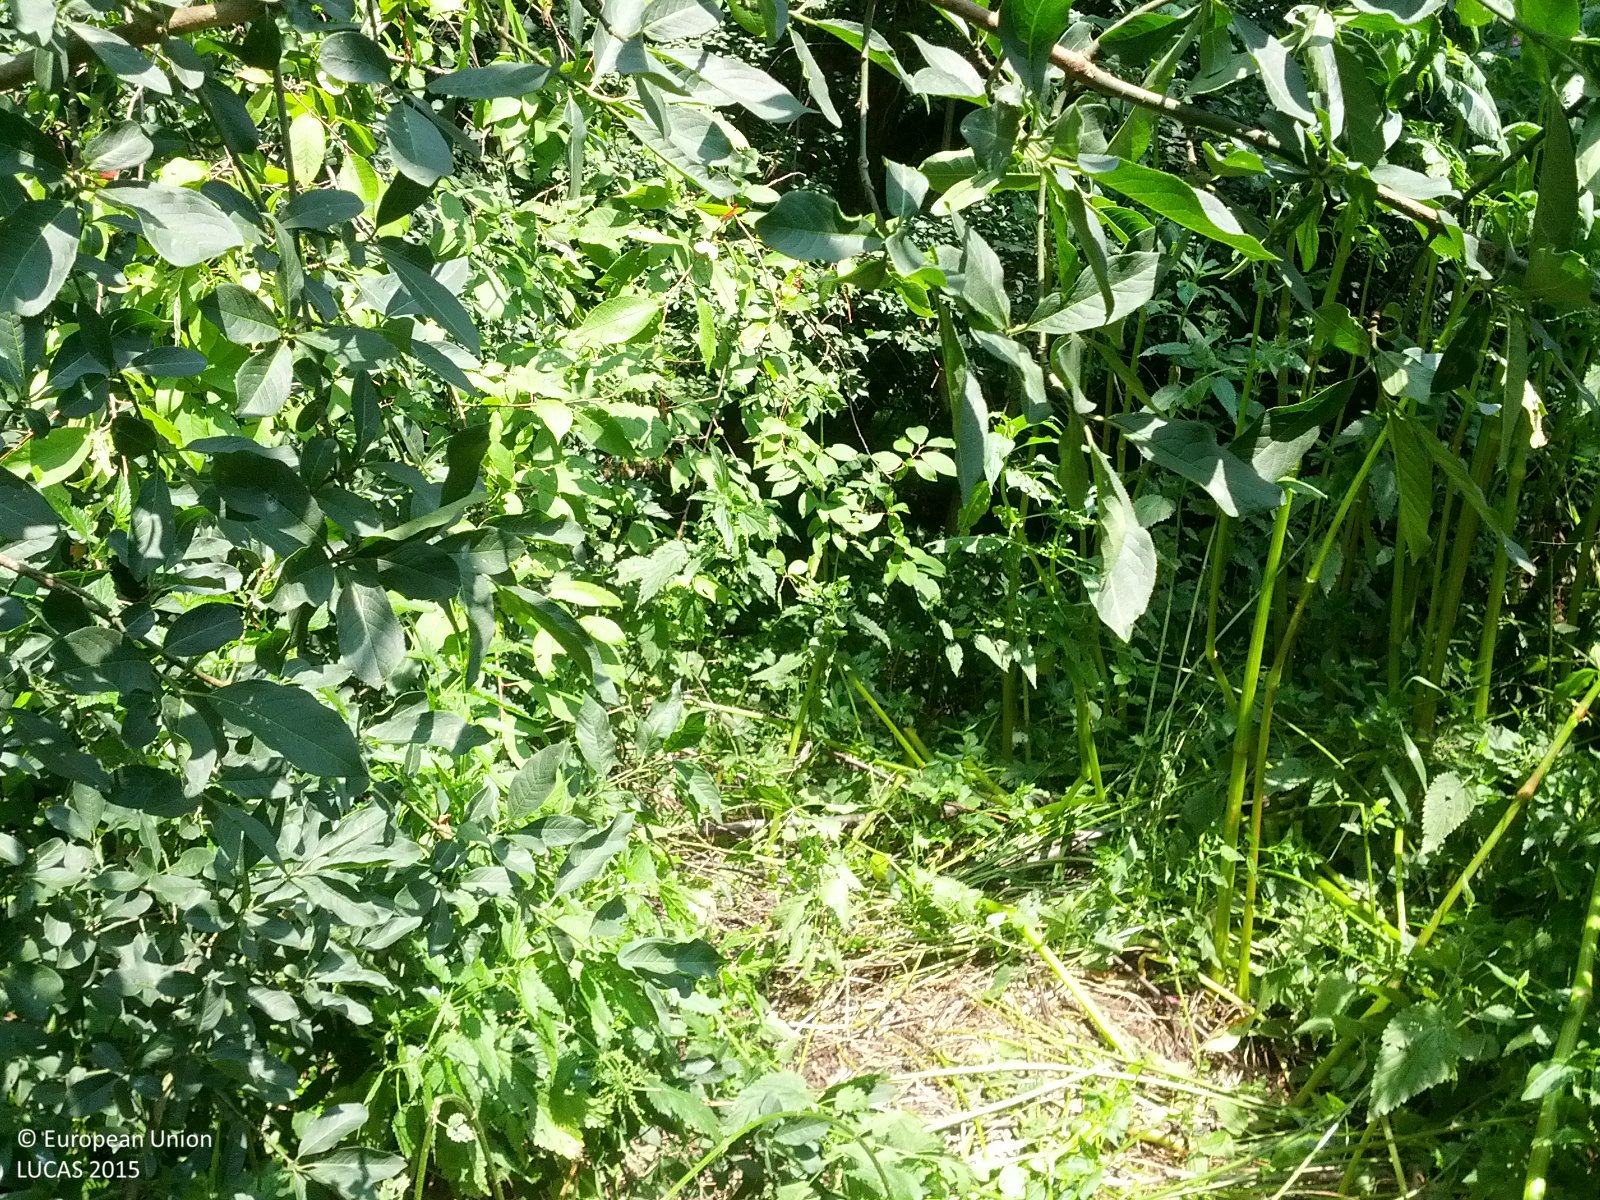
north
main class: Woodland
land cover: Broadleaved woodland
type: floodplain forest
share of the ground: > 75 %
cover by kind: broadleaved forest trees 75 %, herbaceous plants 20 %, shrubs 5 %
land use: Semi-natural and natural areas not in use
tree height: > 5 m
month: July
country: AT
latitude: 47.2429
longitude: 16.0921
